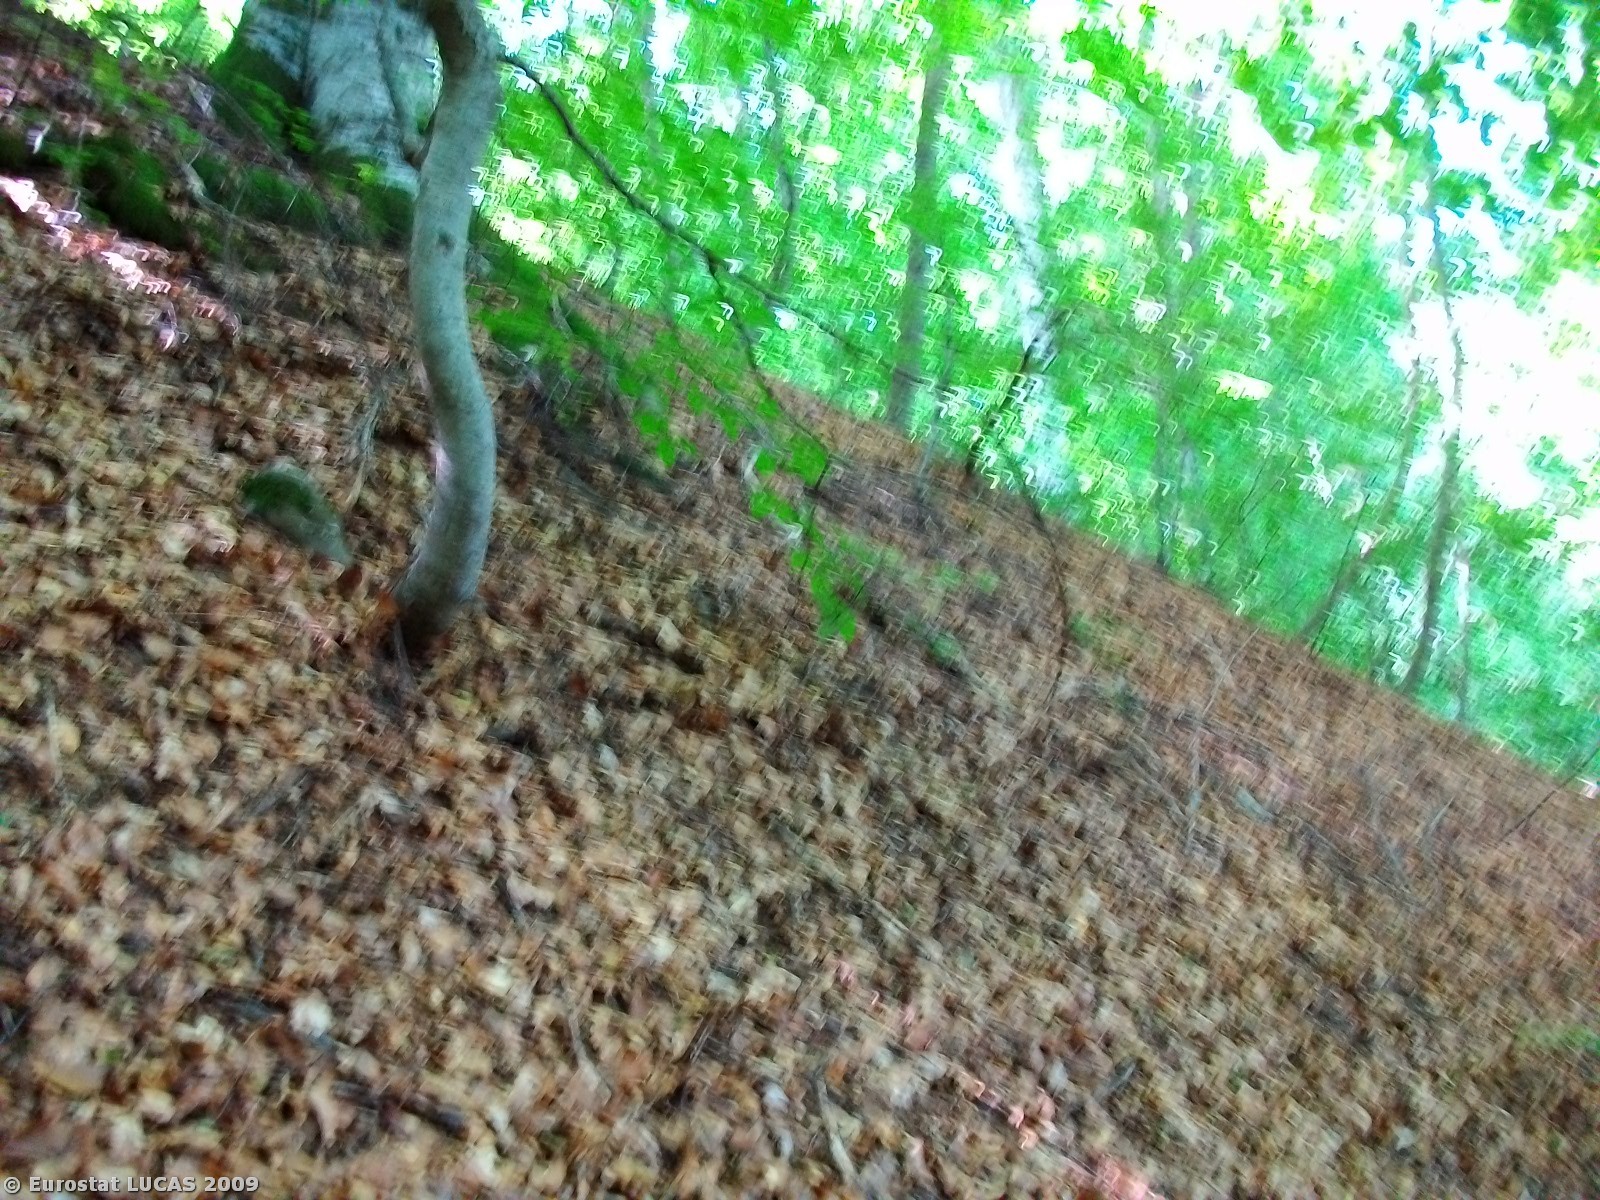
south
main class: Woodland
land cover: Broadleaved woodland
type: thermophilous deciduous forest
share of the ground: > 75 %
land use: Forestry
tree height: > 5 m
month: July
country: GR
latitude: 41.1799
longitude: 24.5197
